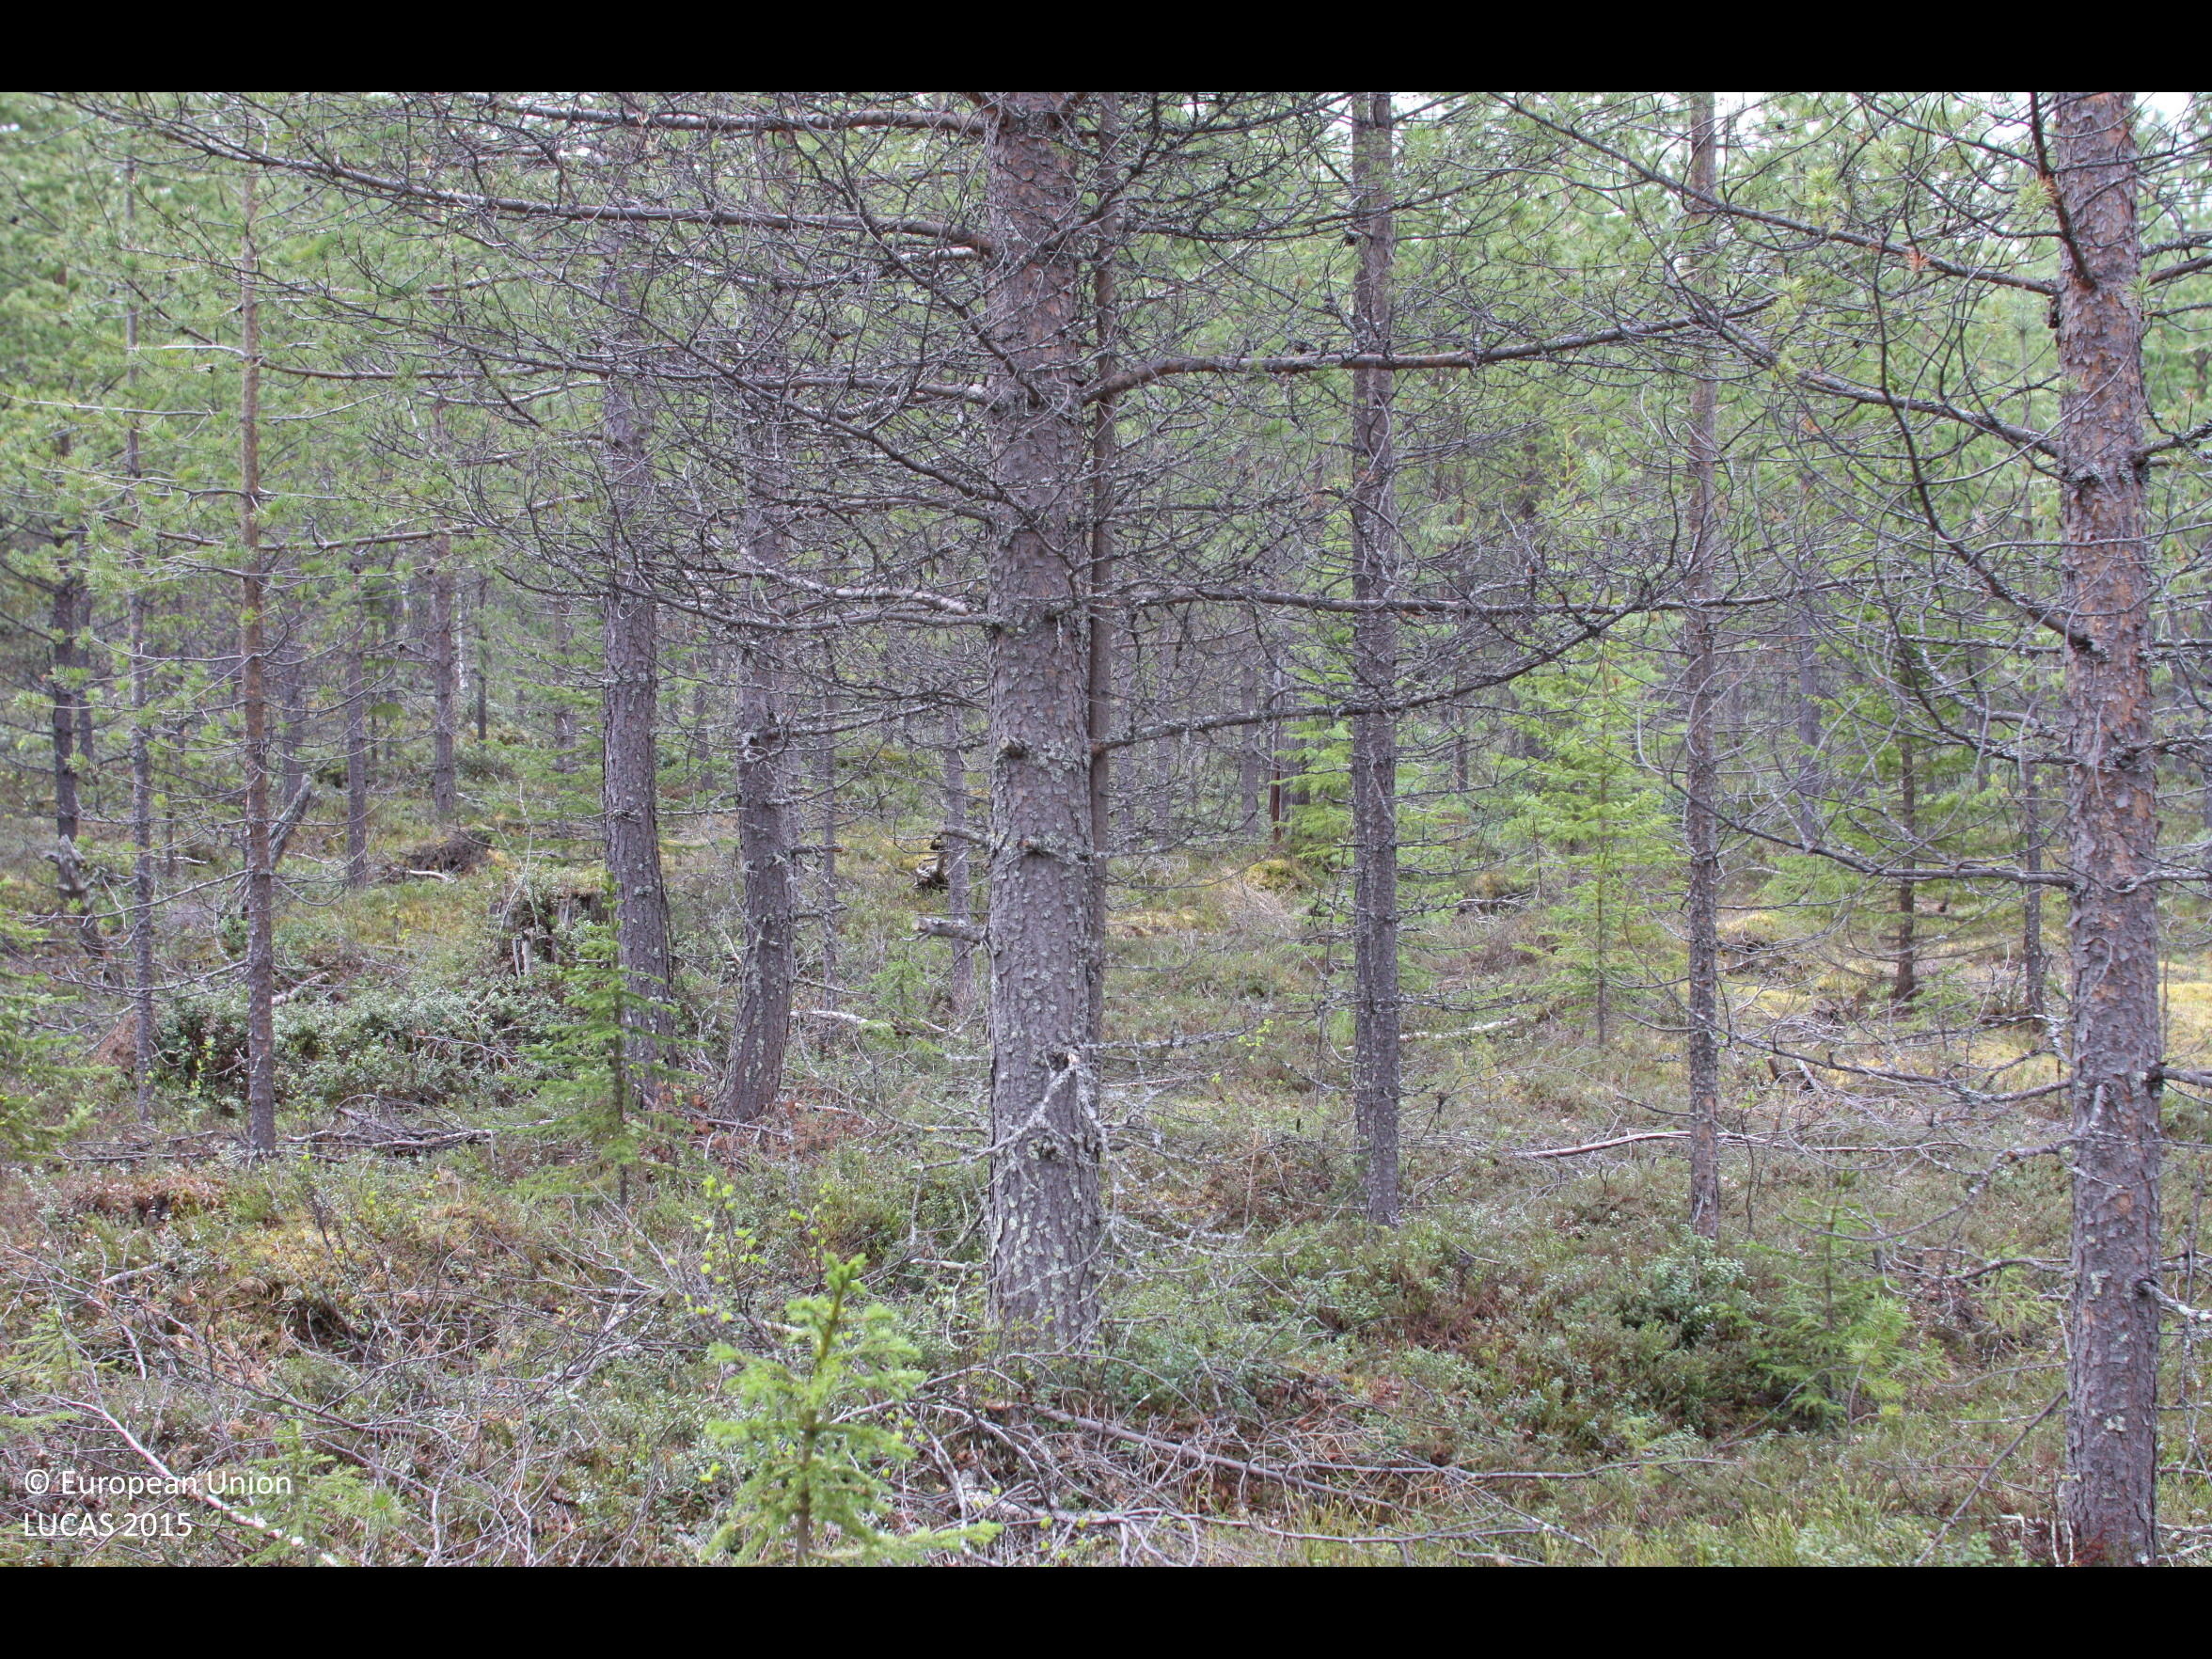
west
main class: Woodland
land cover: Pine dominated coniferous woodland
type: boreal forest
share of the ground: > 75 %
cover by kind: coniferous forest trees 70 %, shrubs 20 %, broadleaved forest trees 5 %, lichens and mosses 5 %
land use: Forestry
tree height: > 5 m
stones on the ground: < 10 %
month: June
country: FI
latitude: 66.1751
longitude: 27.8104
